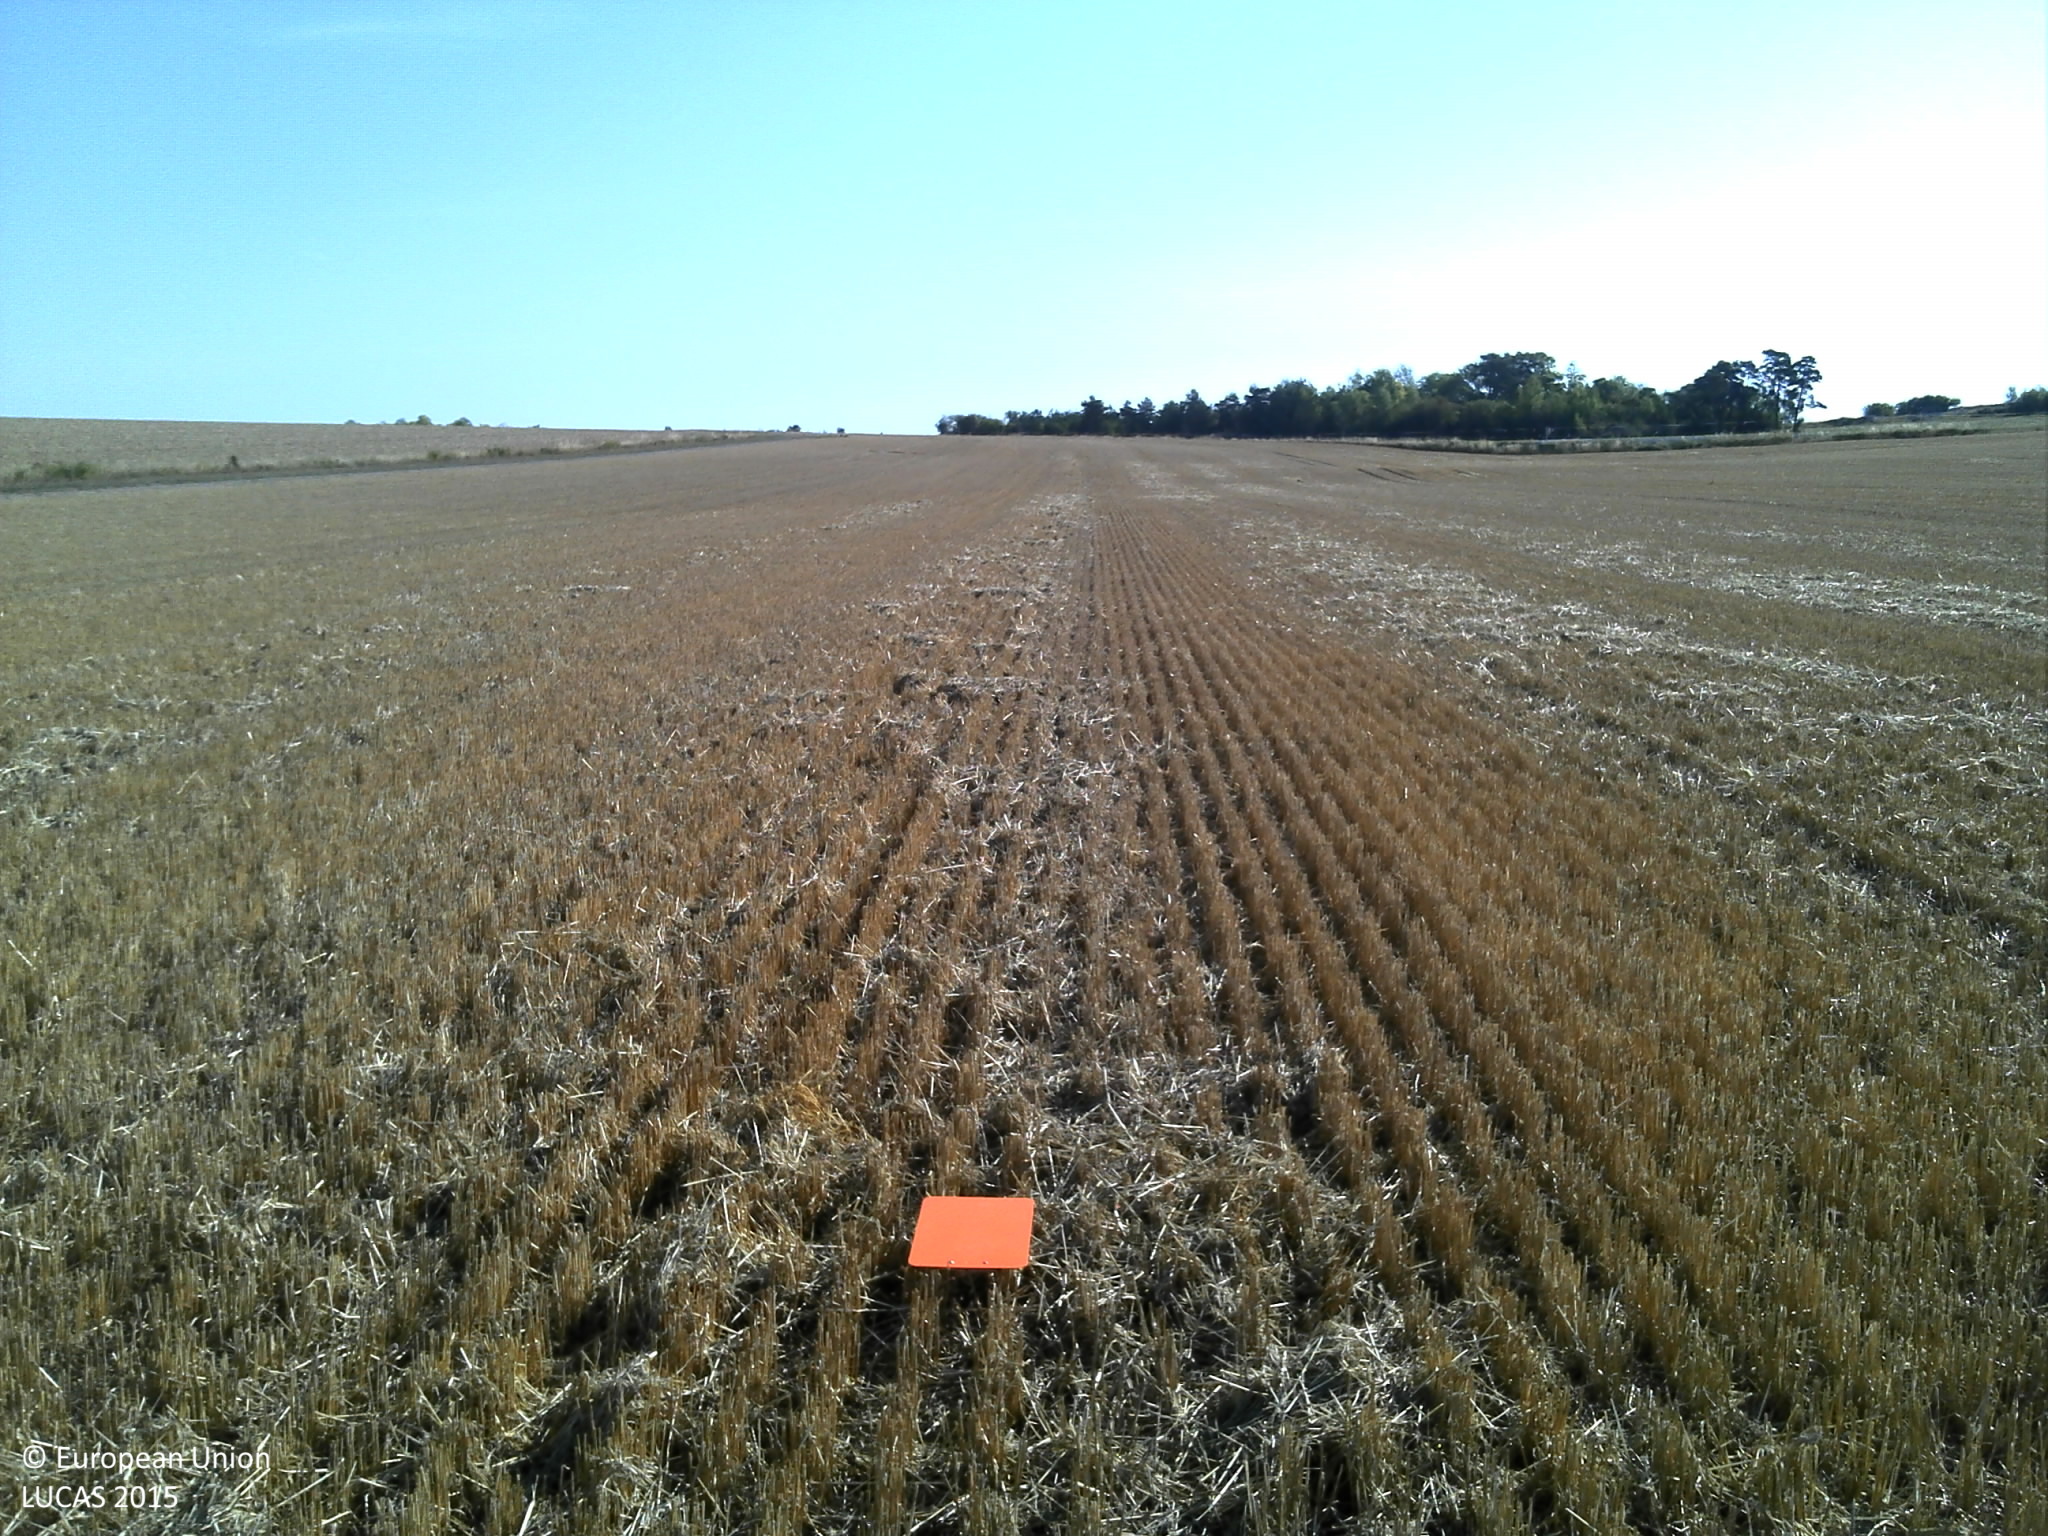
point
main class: Cropland
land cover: Barley
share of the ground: > 75 %
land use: Agriculture (excluding fallow land and kitchen gardens)
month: August
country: FR
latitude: 48.6151
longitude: 4.2586
